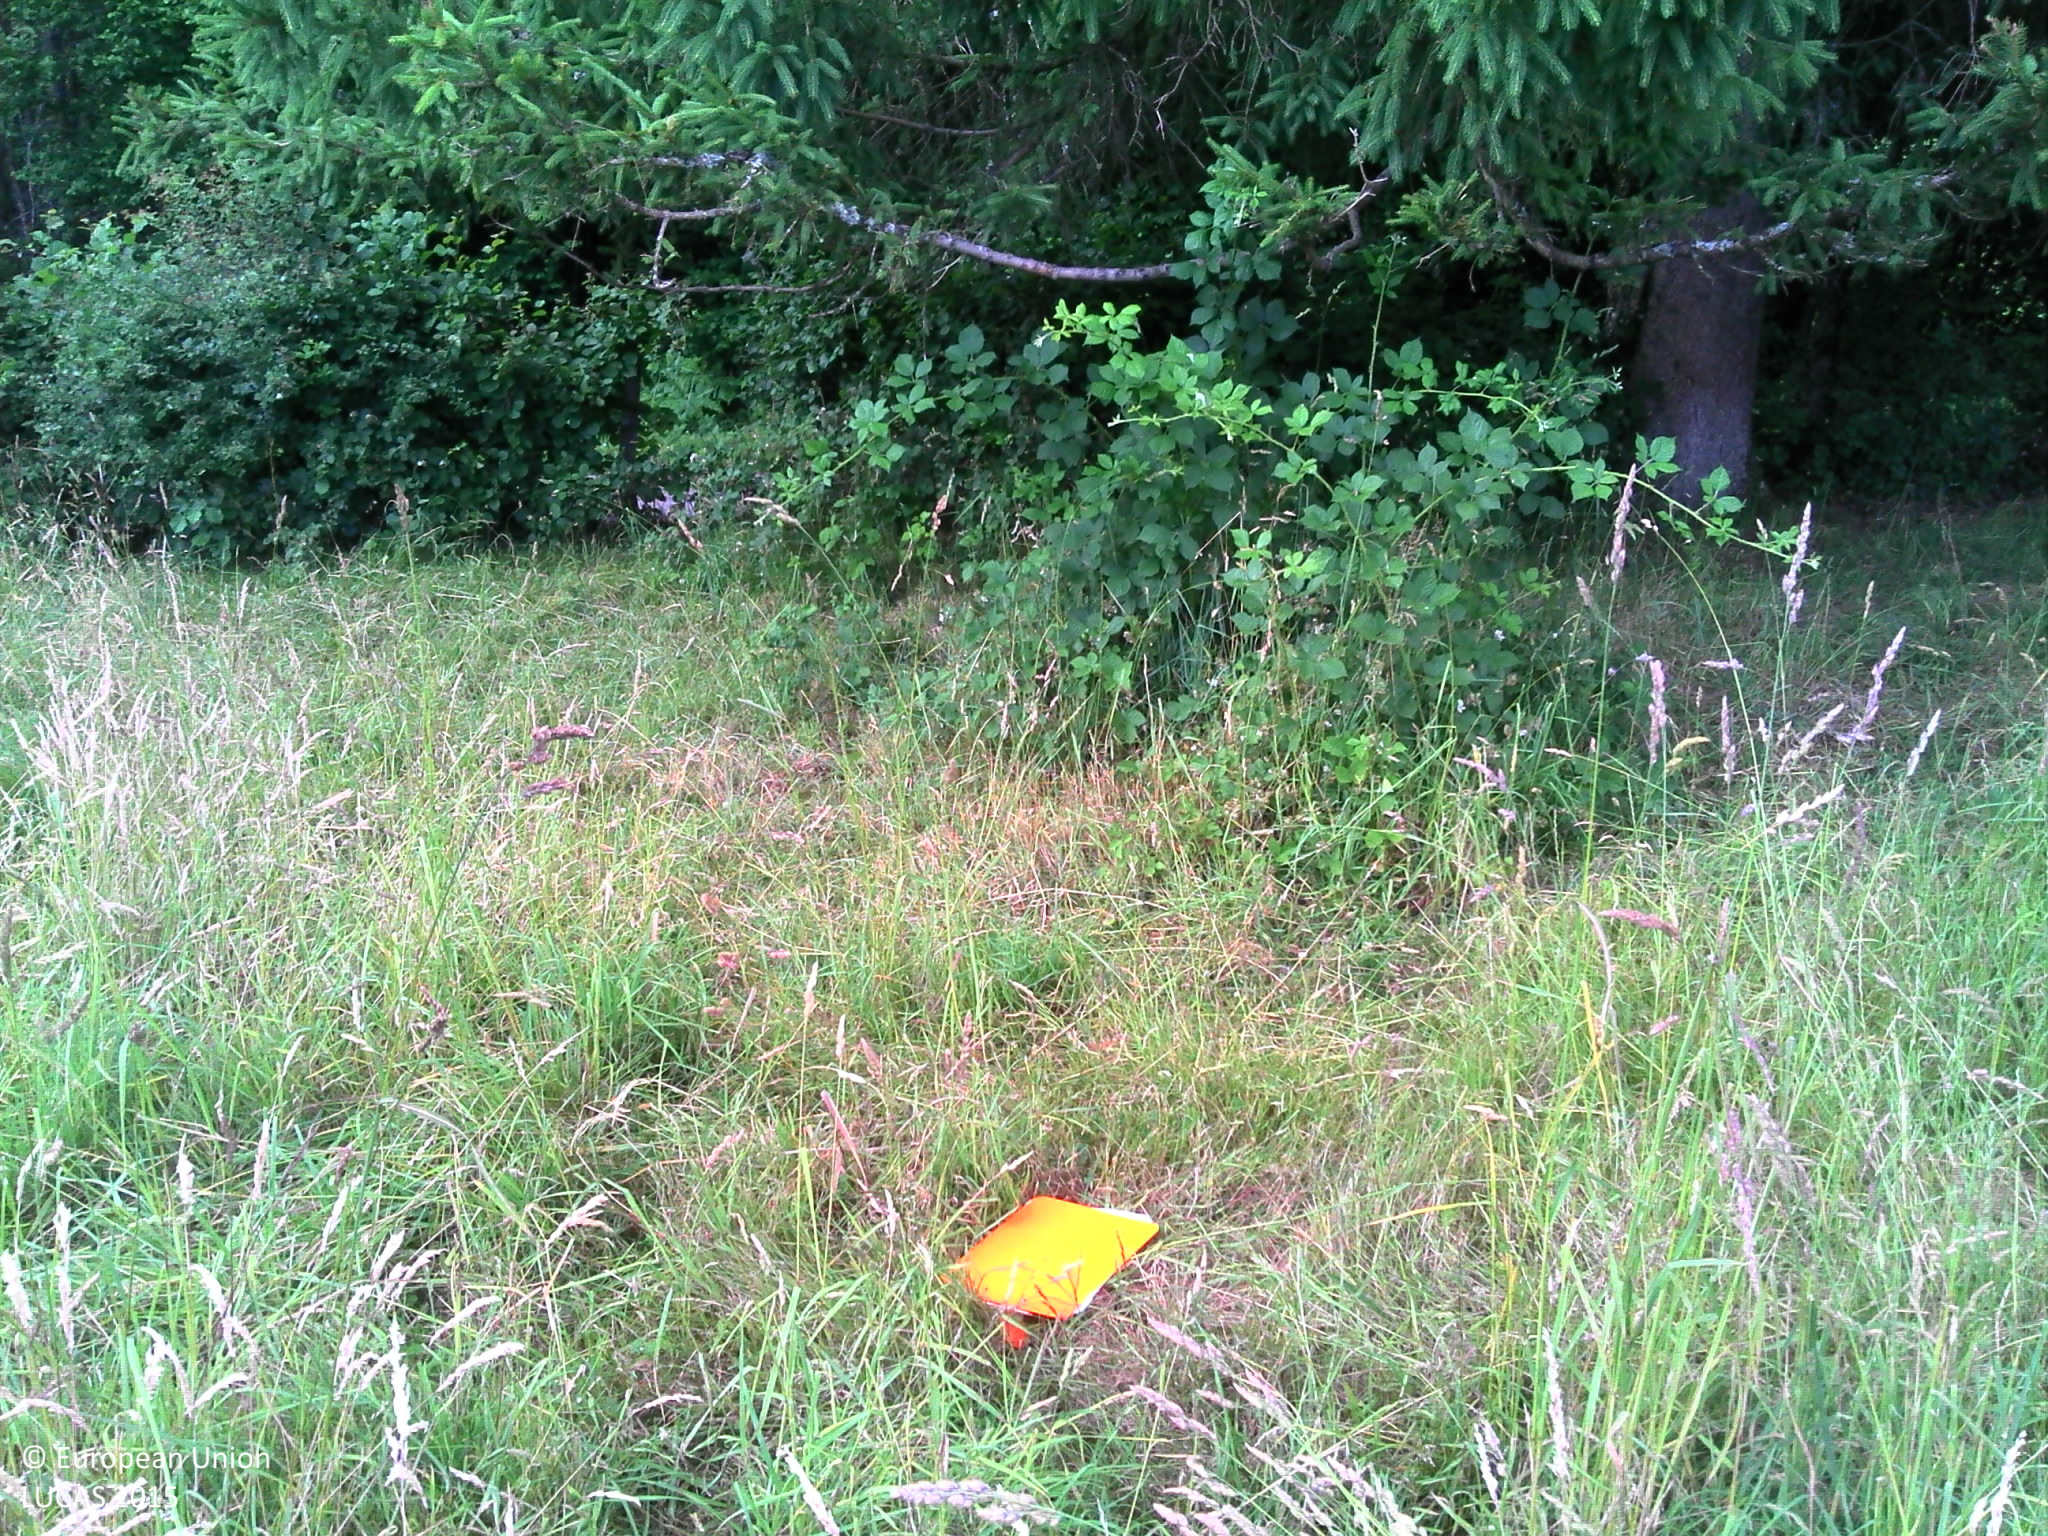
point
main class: Grassland
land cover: Grassland without tree/shrub cover
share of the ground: > 75 %
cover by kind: herbaceous plants 100 %
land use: Agriculture (excluding fallow land and kitchen gardens)
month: June
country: FR
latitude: 47.2293
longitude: 3.9889
